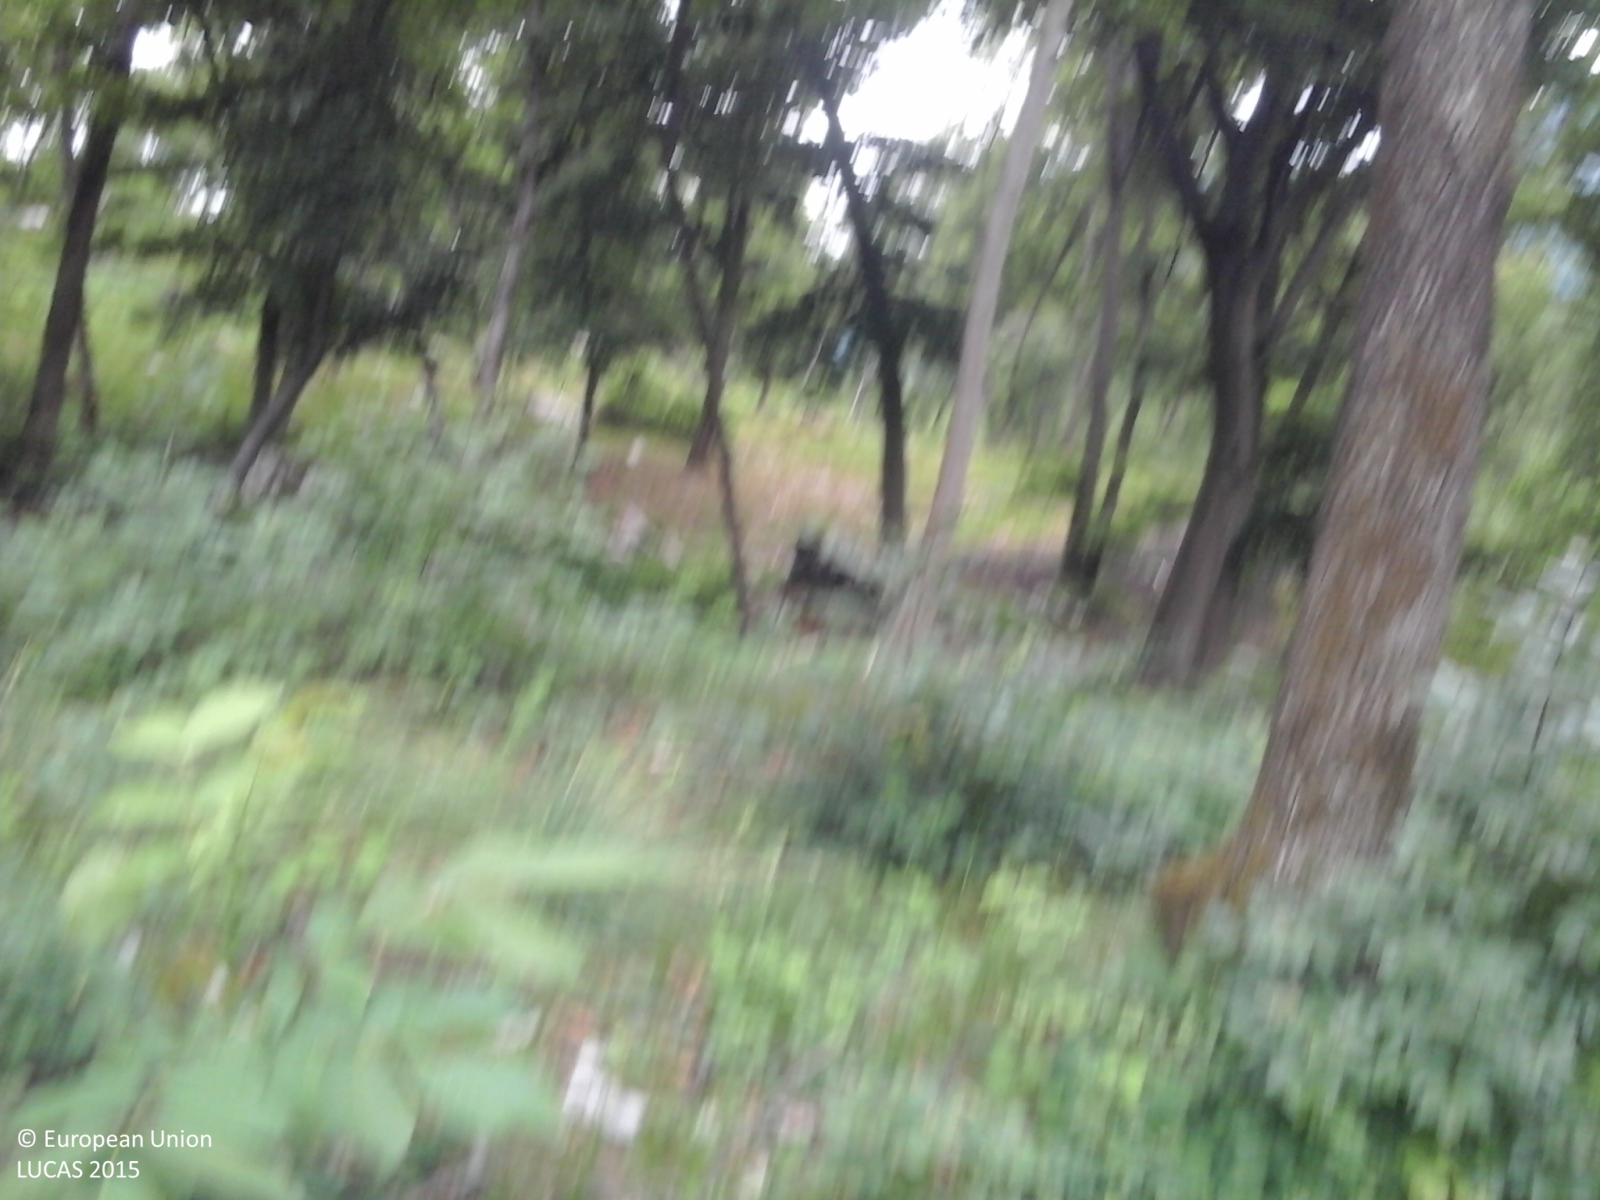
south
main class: Woodland
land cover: Broadleaved woodland
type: mountainous beech forest
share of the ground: > 75 %
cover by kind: broadleaved forest trees 90 %, herbaceous plants 10 %
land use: Forestry
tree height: > 5 m
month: May
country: IT
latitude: 45.6985
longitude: 10.9360
